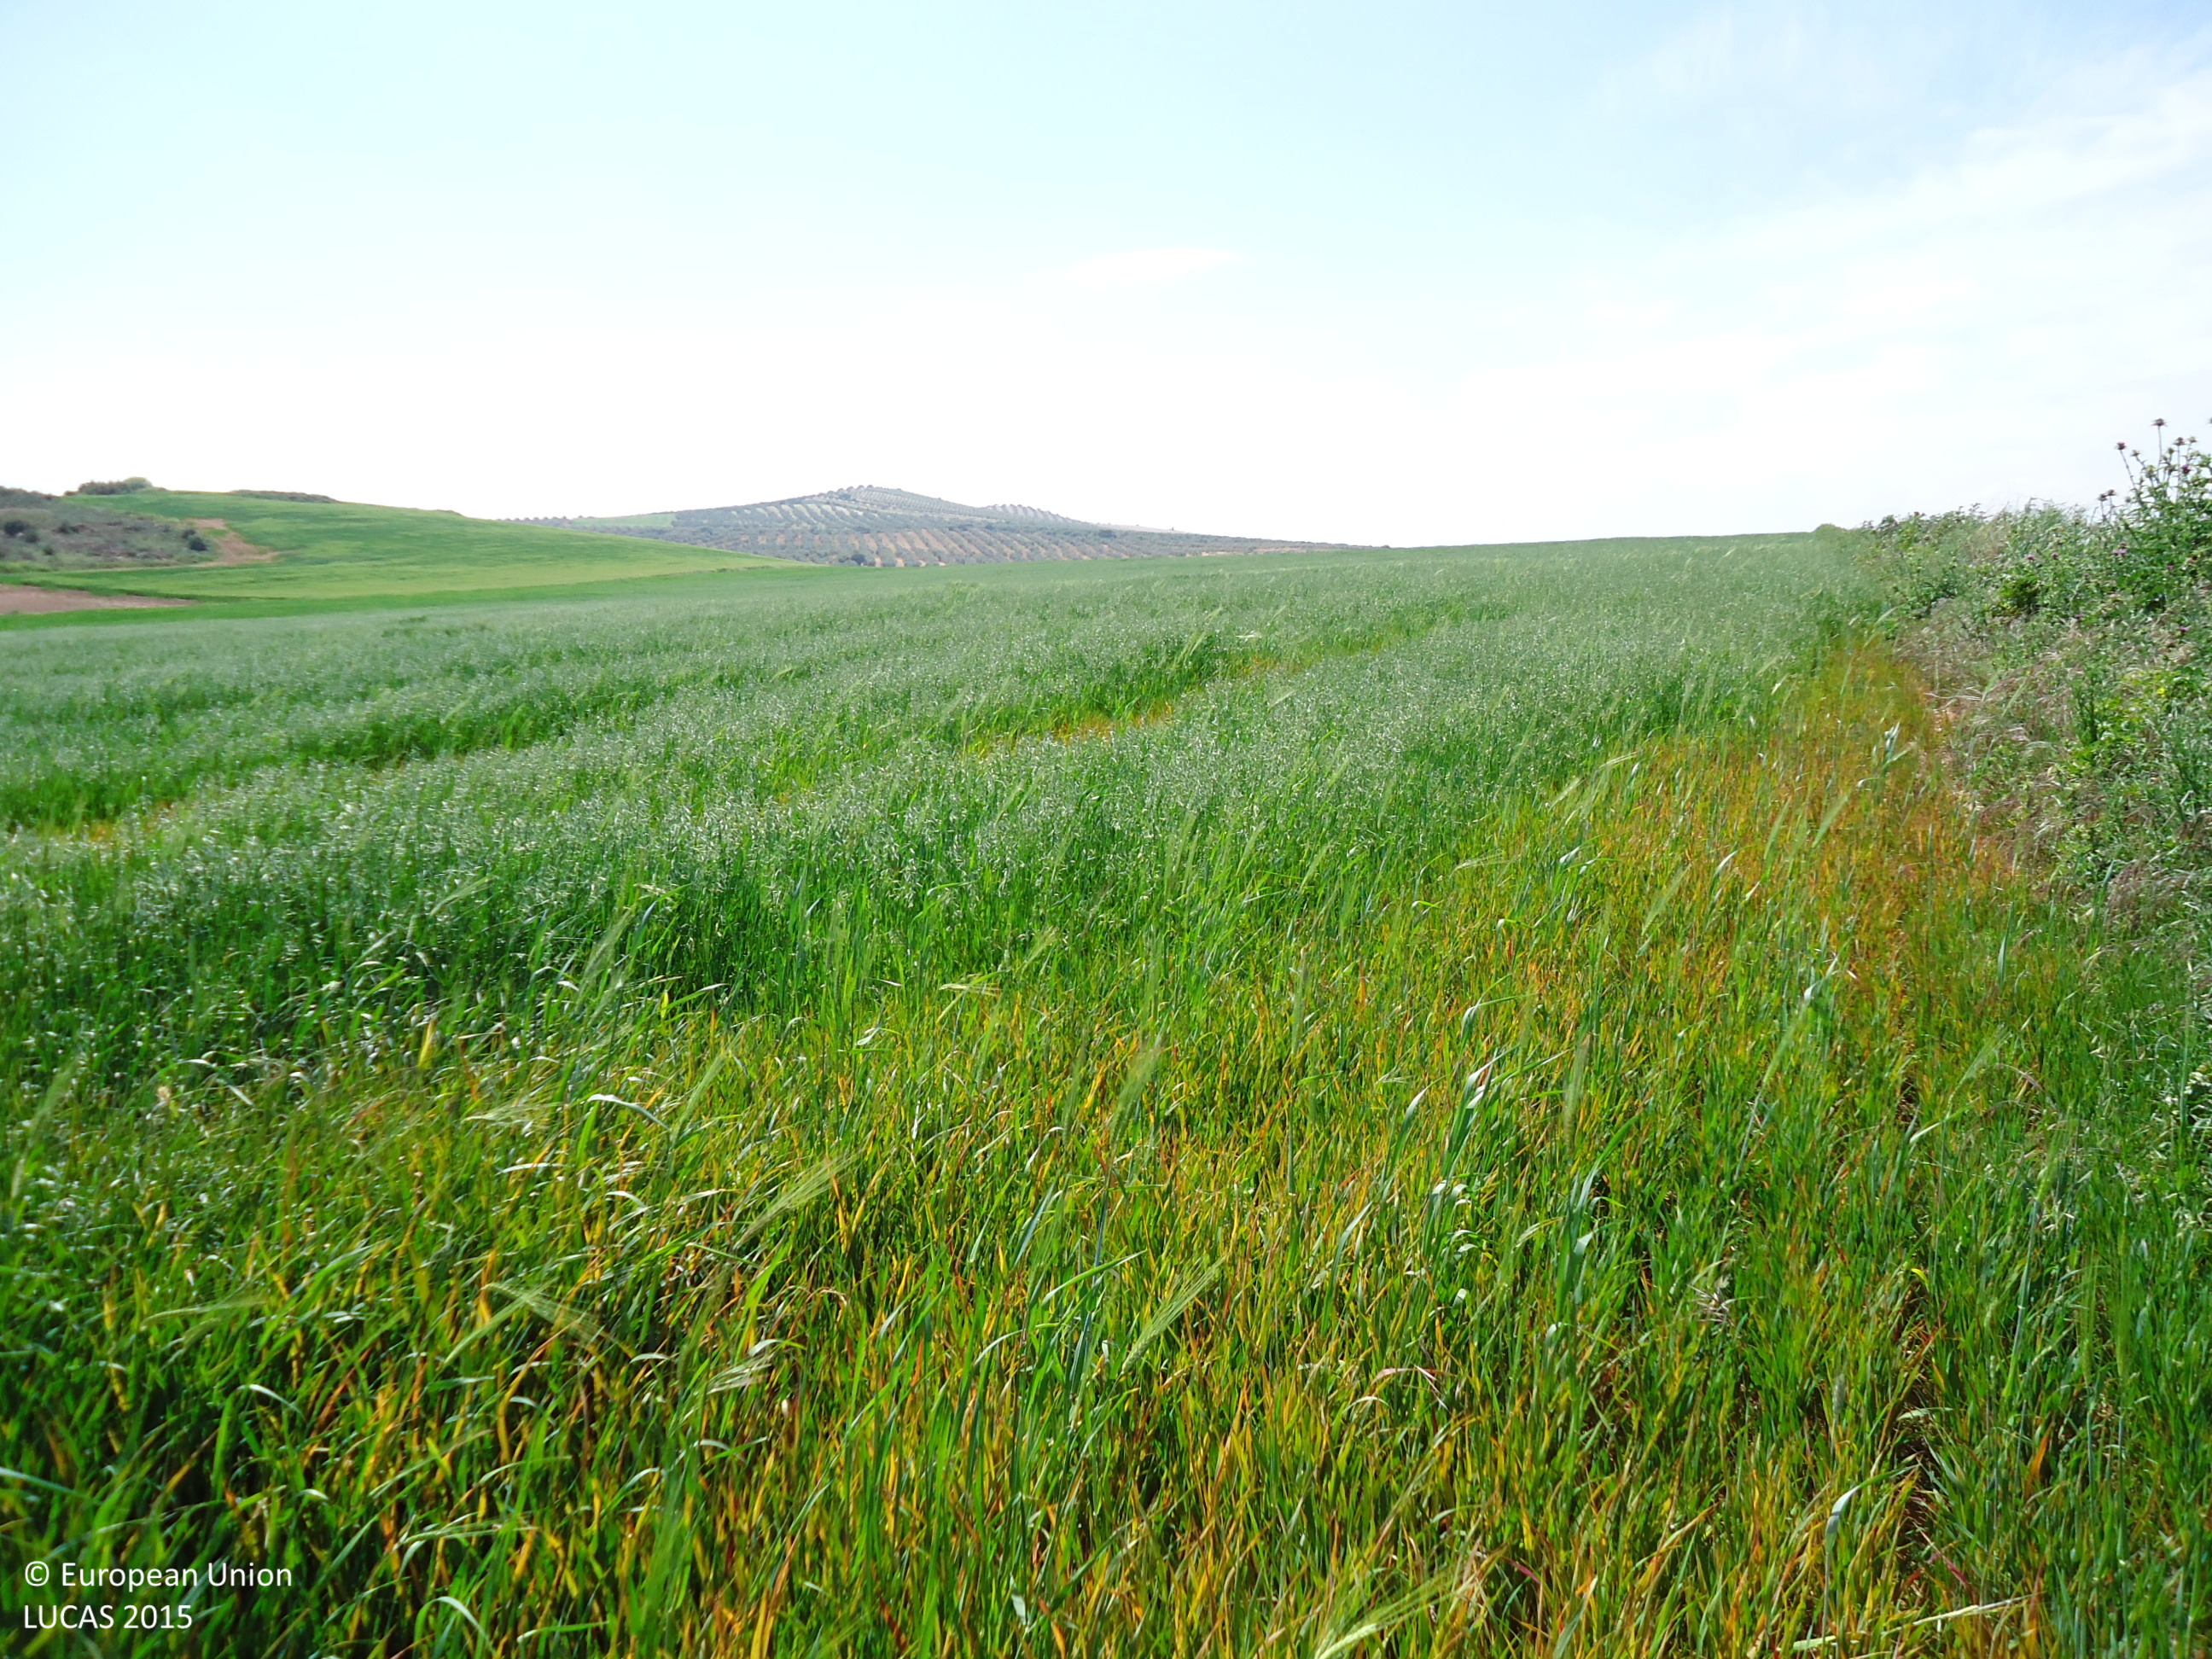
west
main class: Cropland
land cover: Oats
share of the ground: > 75 %
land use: Agriculture (excluding fallow land and kitchen gardens)
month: April
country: ES
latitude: 37.0414
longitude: -4.8073
